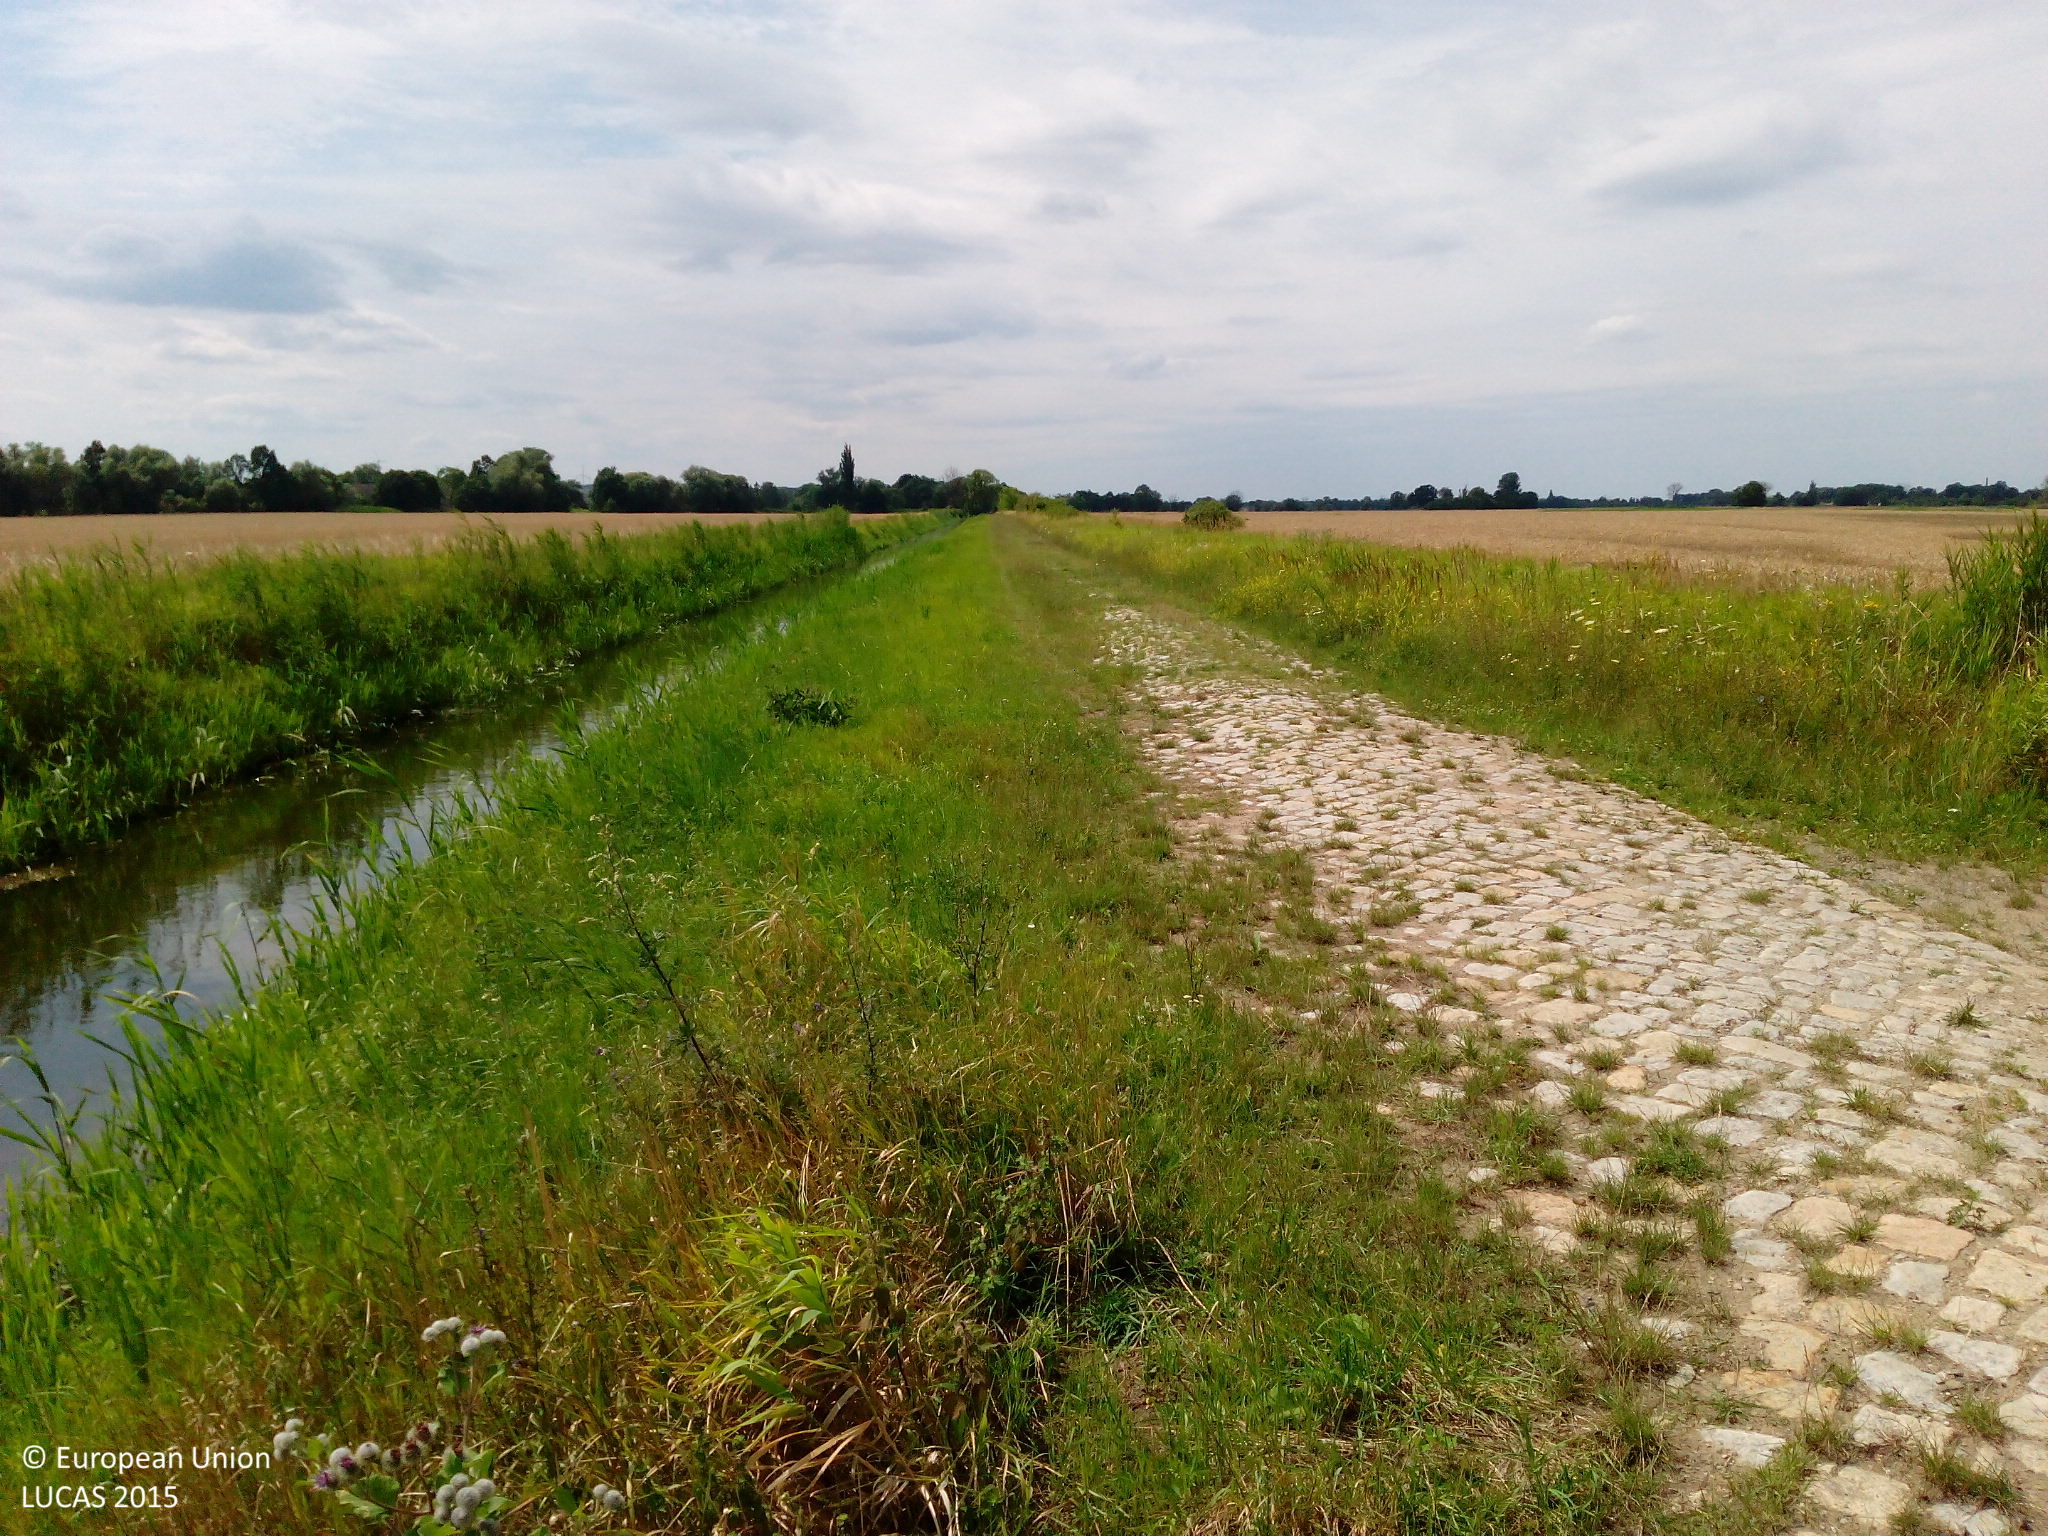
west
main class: Cropland
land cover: Common wheat
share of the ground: > 75 %
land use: Agriculture (excluding fallow land and kitchen gardens)
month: July
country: DE
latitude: 52.5645
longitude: 14.4419
